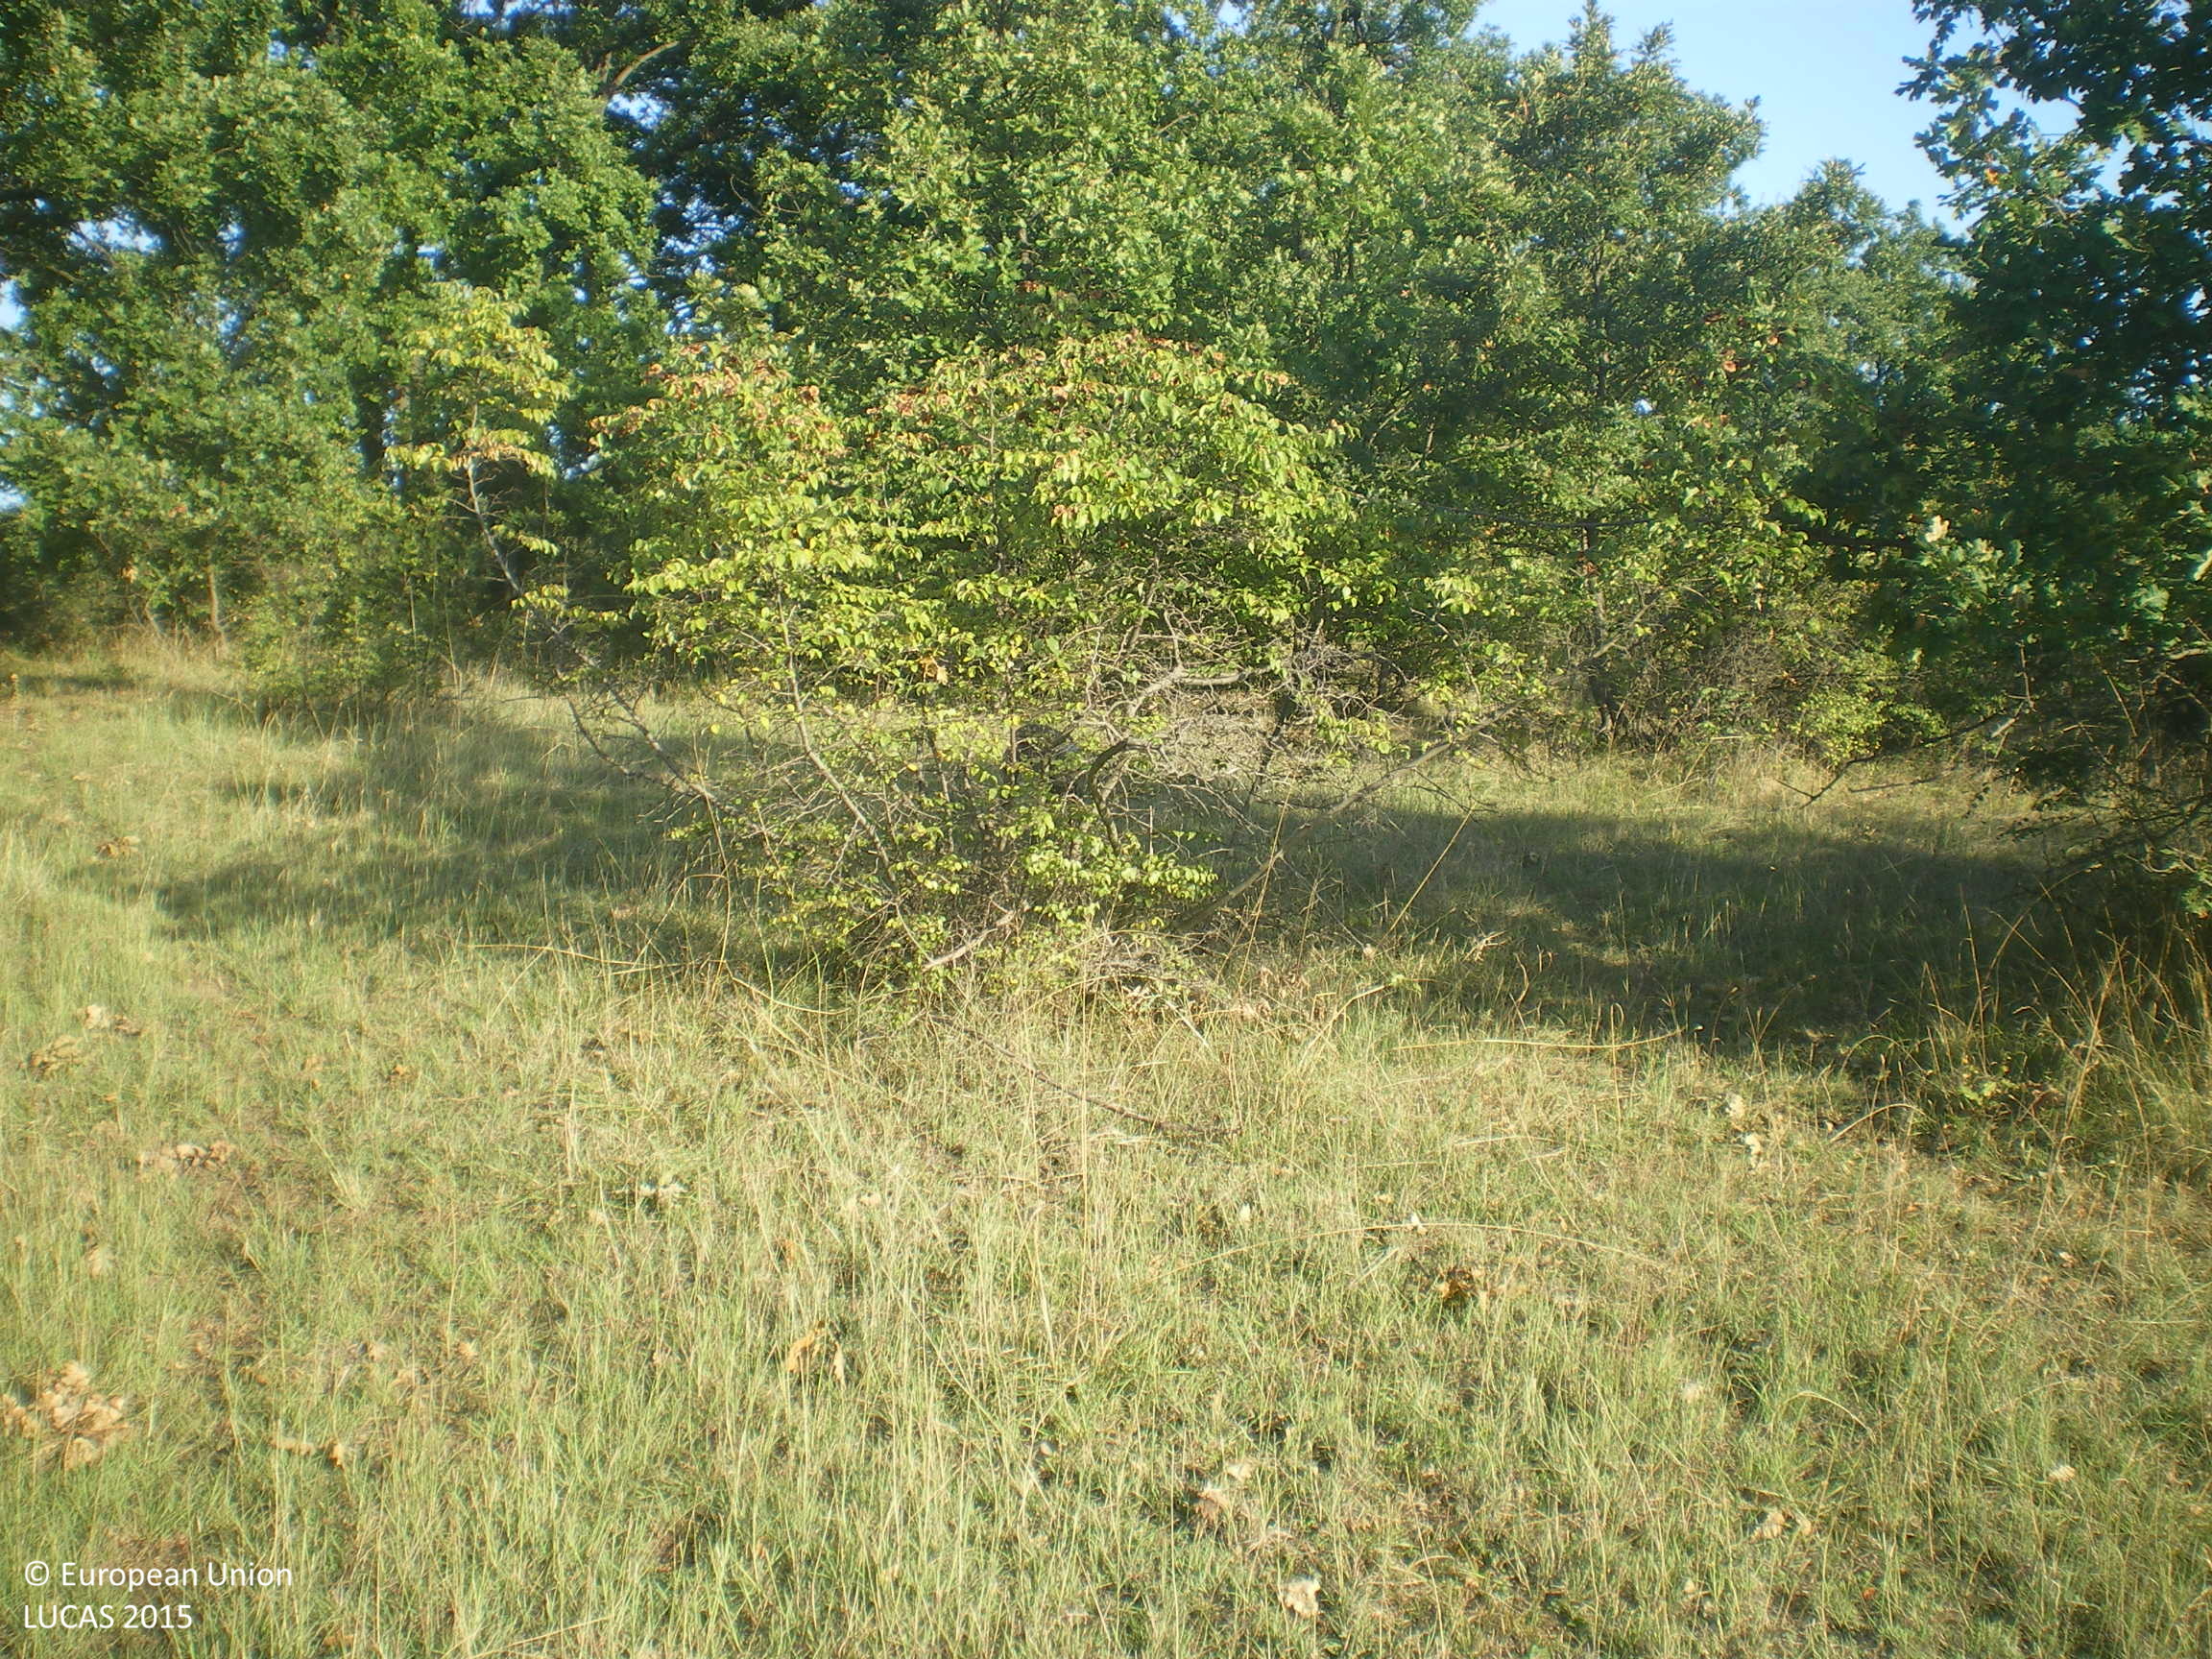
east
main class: Grassland
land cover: Grassland with sparse tree/shrub cover
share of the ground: > 75 %
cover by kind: herbaceous plants 85 %, shrubs 10 %, broadleaved forest trees 5 %
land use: Agriculture (excluding fallow land and kitchen gardens)
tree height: > 5 m
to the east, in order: Grassland with sparse tree/shrub cover; Broadleaved woodland; Shrubland with sparse tree cover; Ditches and canals; Shruby margins; Grassland with sparse tree/shrub cover; Broadleaved woodland; Grassland without tree/shrub cover; Shrubland with sparse tree cover; Tracks; Broadleaved woodland
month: September
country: BG
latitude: 41.8051
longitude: 25.8234
